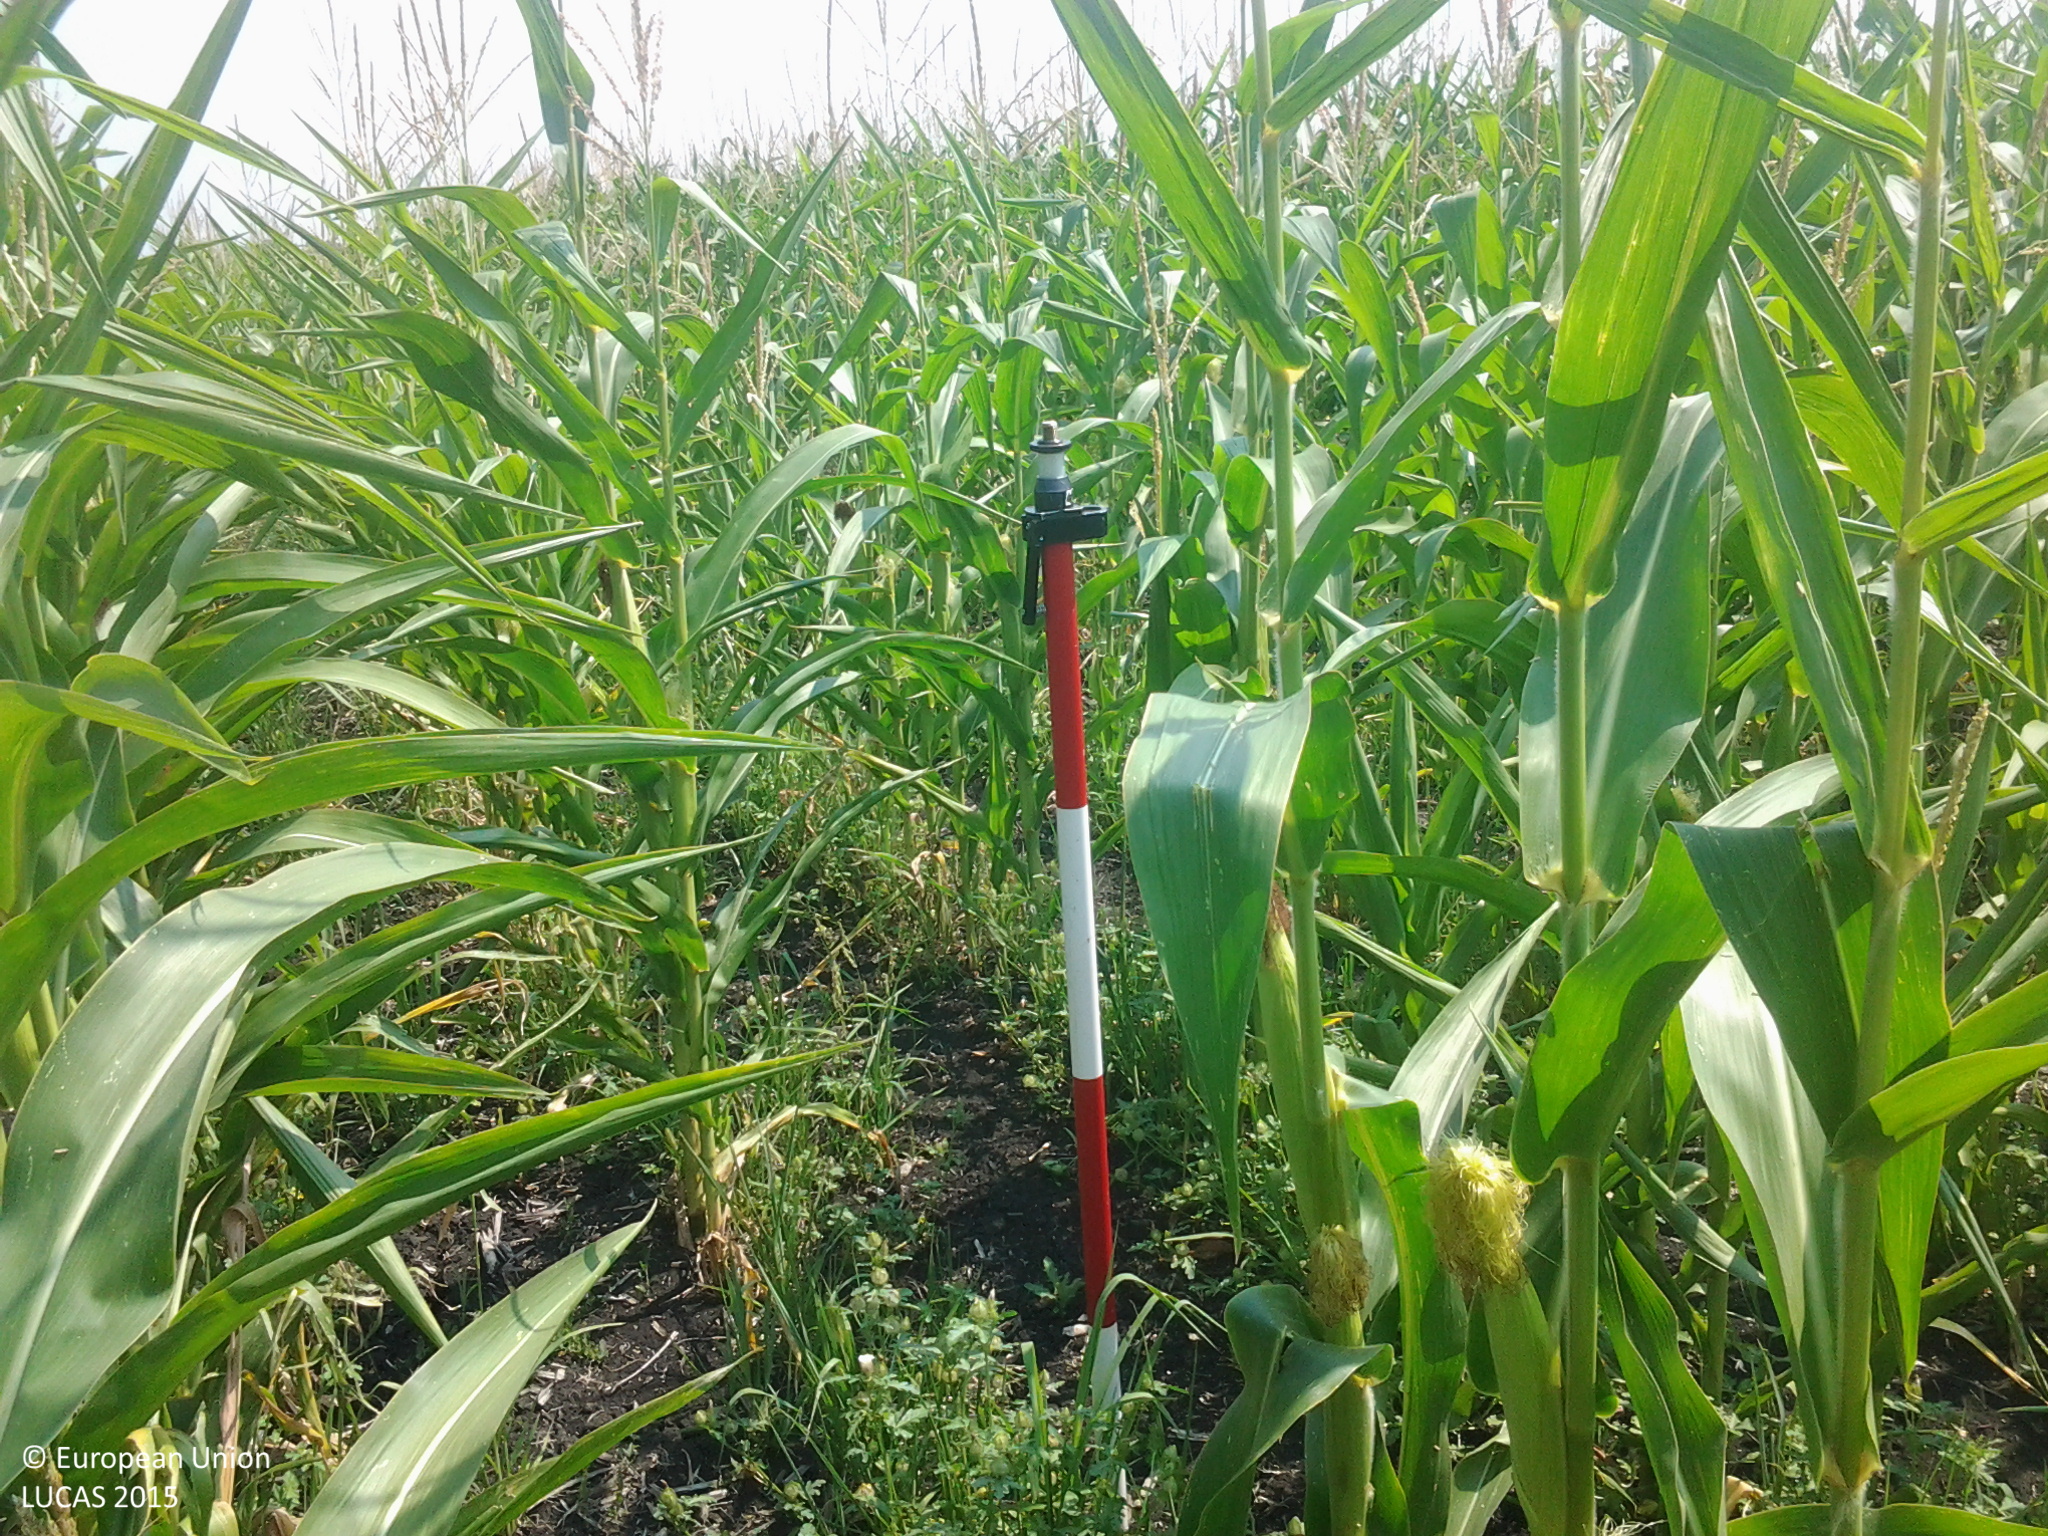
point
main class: Cropland
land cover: Maize
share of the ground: > 75 %
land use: Agriculture (excluding fallow land and kitchen gardens)
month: July
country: HU
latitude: 47.5507
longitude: 20.5694
